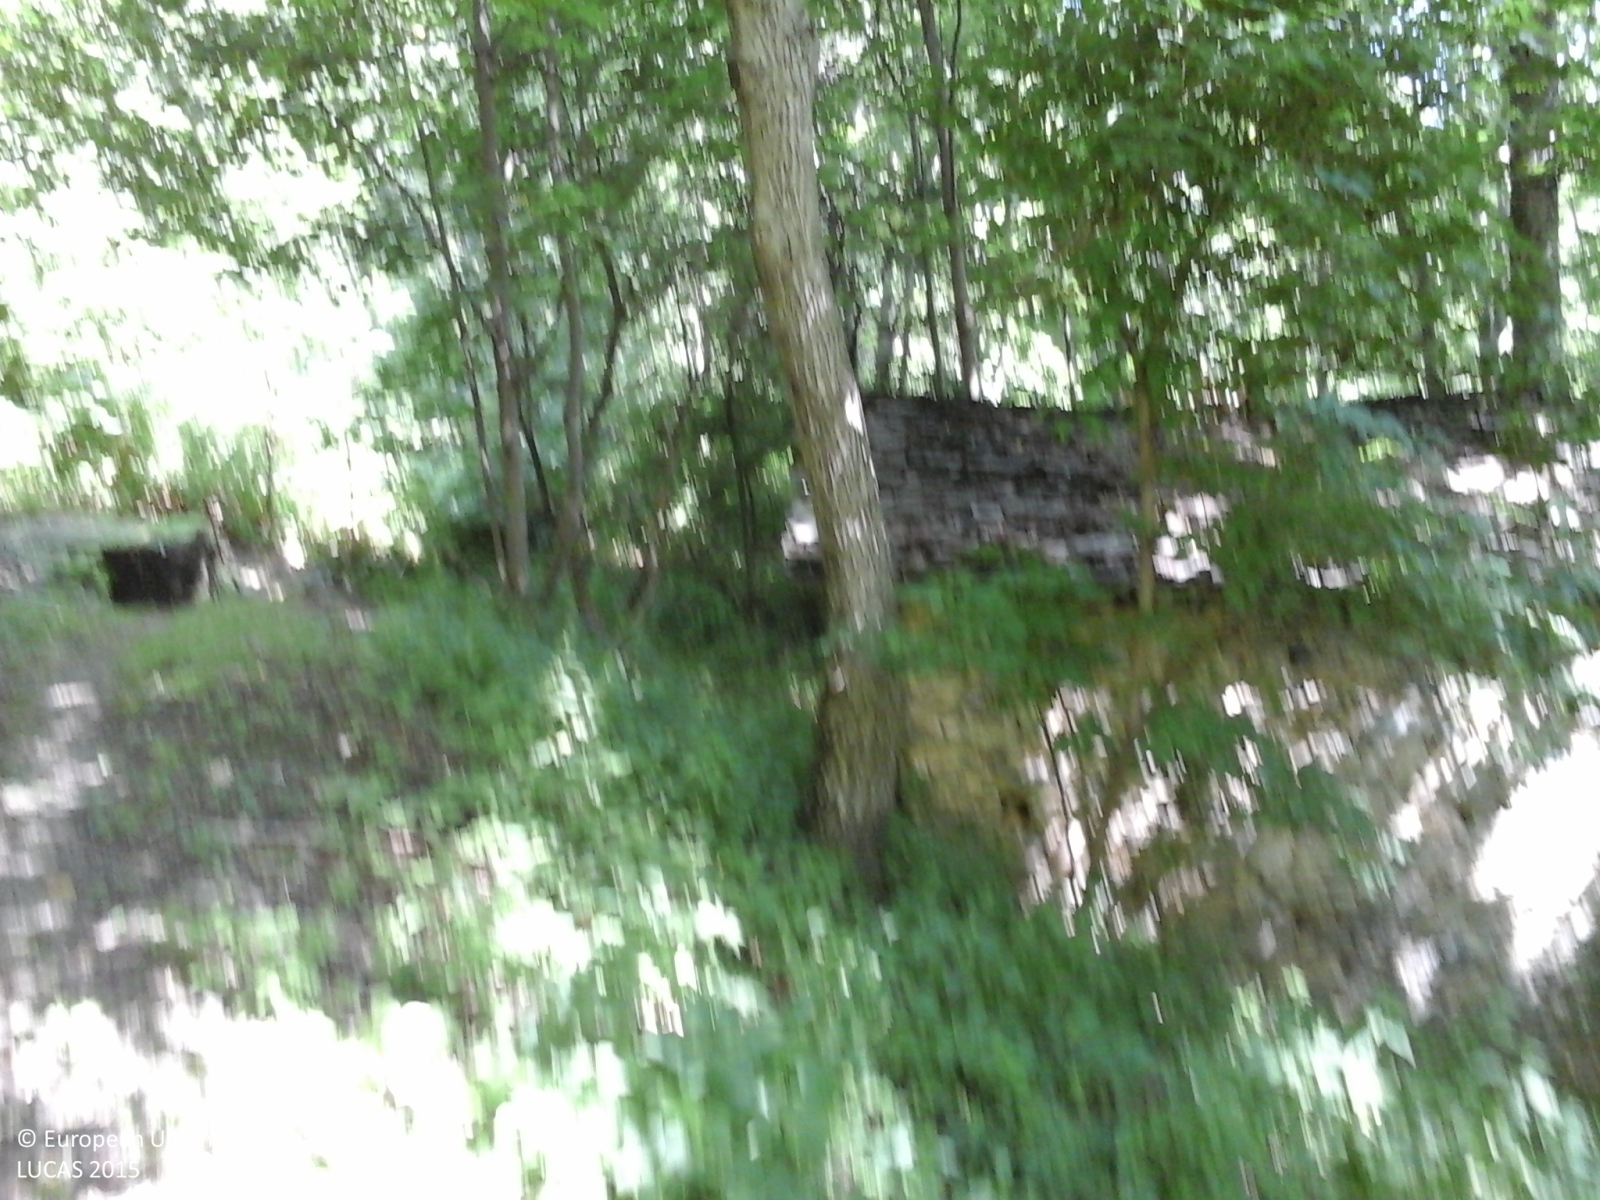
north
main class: Woodland
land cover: Broadleaved woodland
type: mountainous beech forest
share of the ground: > 75 %
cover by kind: broadleaved forest trees 100 %
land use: Forestry
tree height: > 5 m
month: July
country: IT
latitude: 44.3344
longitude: 7.3342
